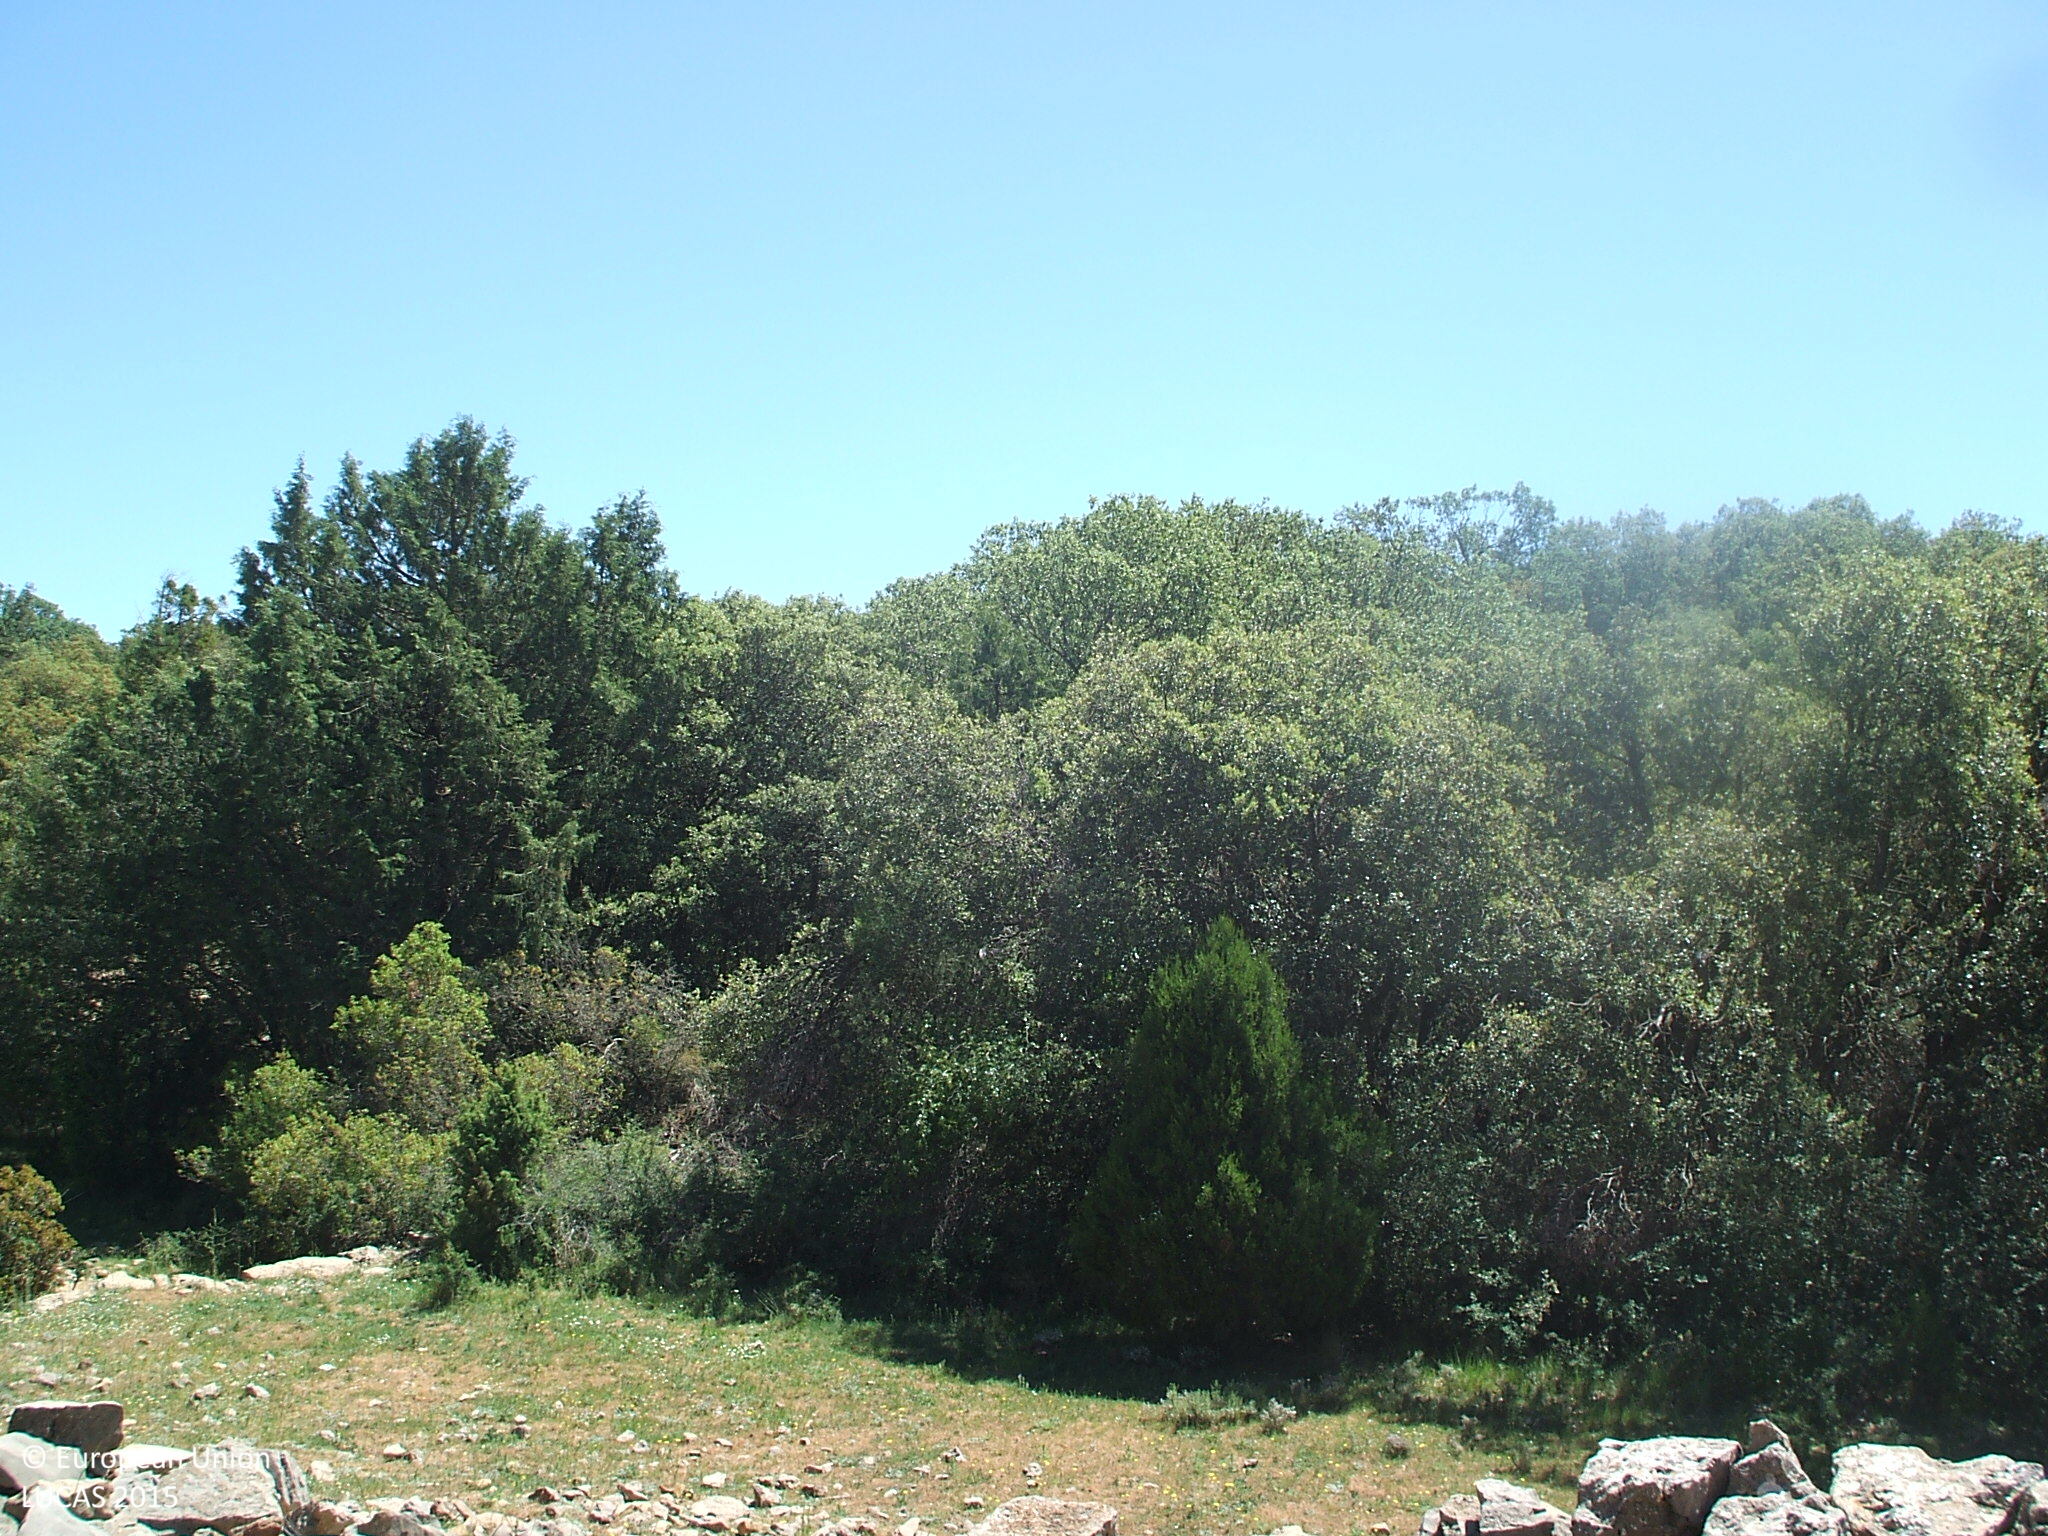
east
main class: Grassland
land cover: Grassland without tree/shrub cover
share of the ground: 25 - 50 %
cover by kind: consolidated bare surface 65 %, herbaceous plants 35 %
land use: Semi-natural and natural areas not in use
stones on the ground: > 50 %
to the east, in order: Grassland without tree/shrub cover; Dry stone walls; Grassland without tree/shrub cover; Broadleaved woodland; Groves; Dry stone walls; Other bare soil; Dry stone walls; Other bare soil; Dry stone walls; Other bare soil; Broadleaved woodland
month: May
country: ES
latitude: 40.0394
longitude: -0.7524
